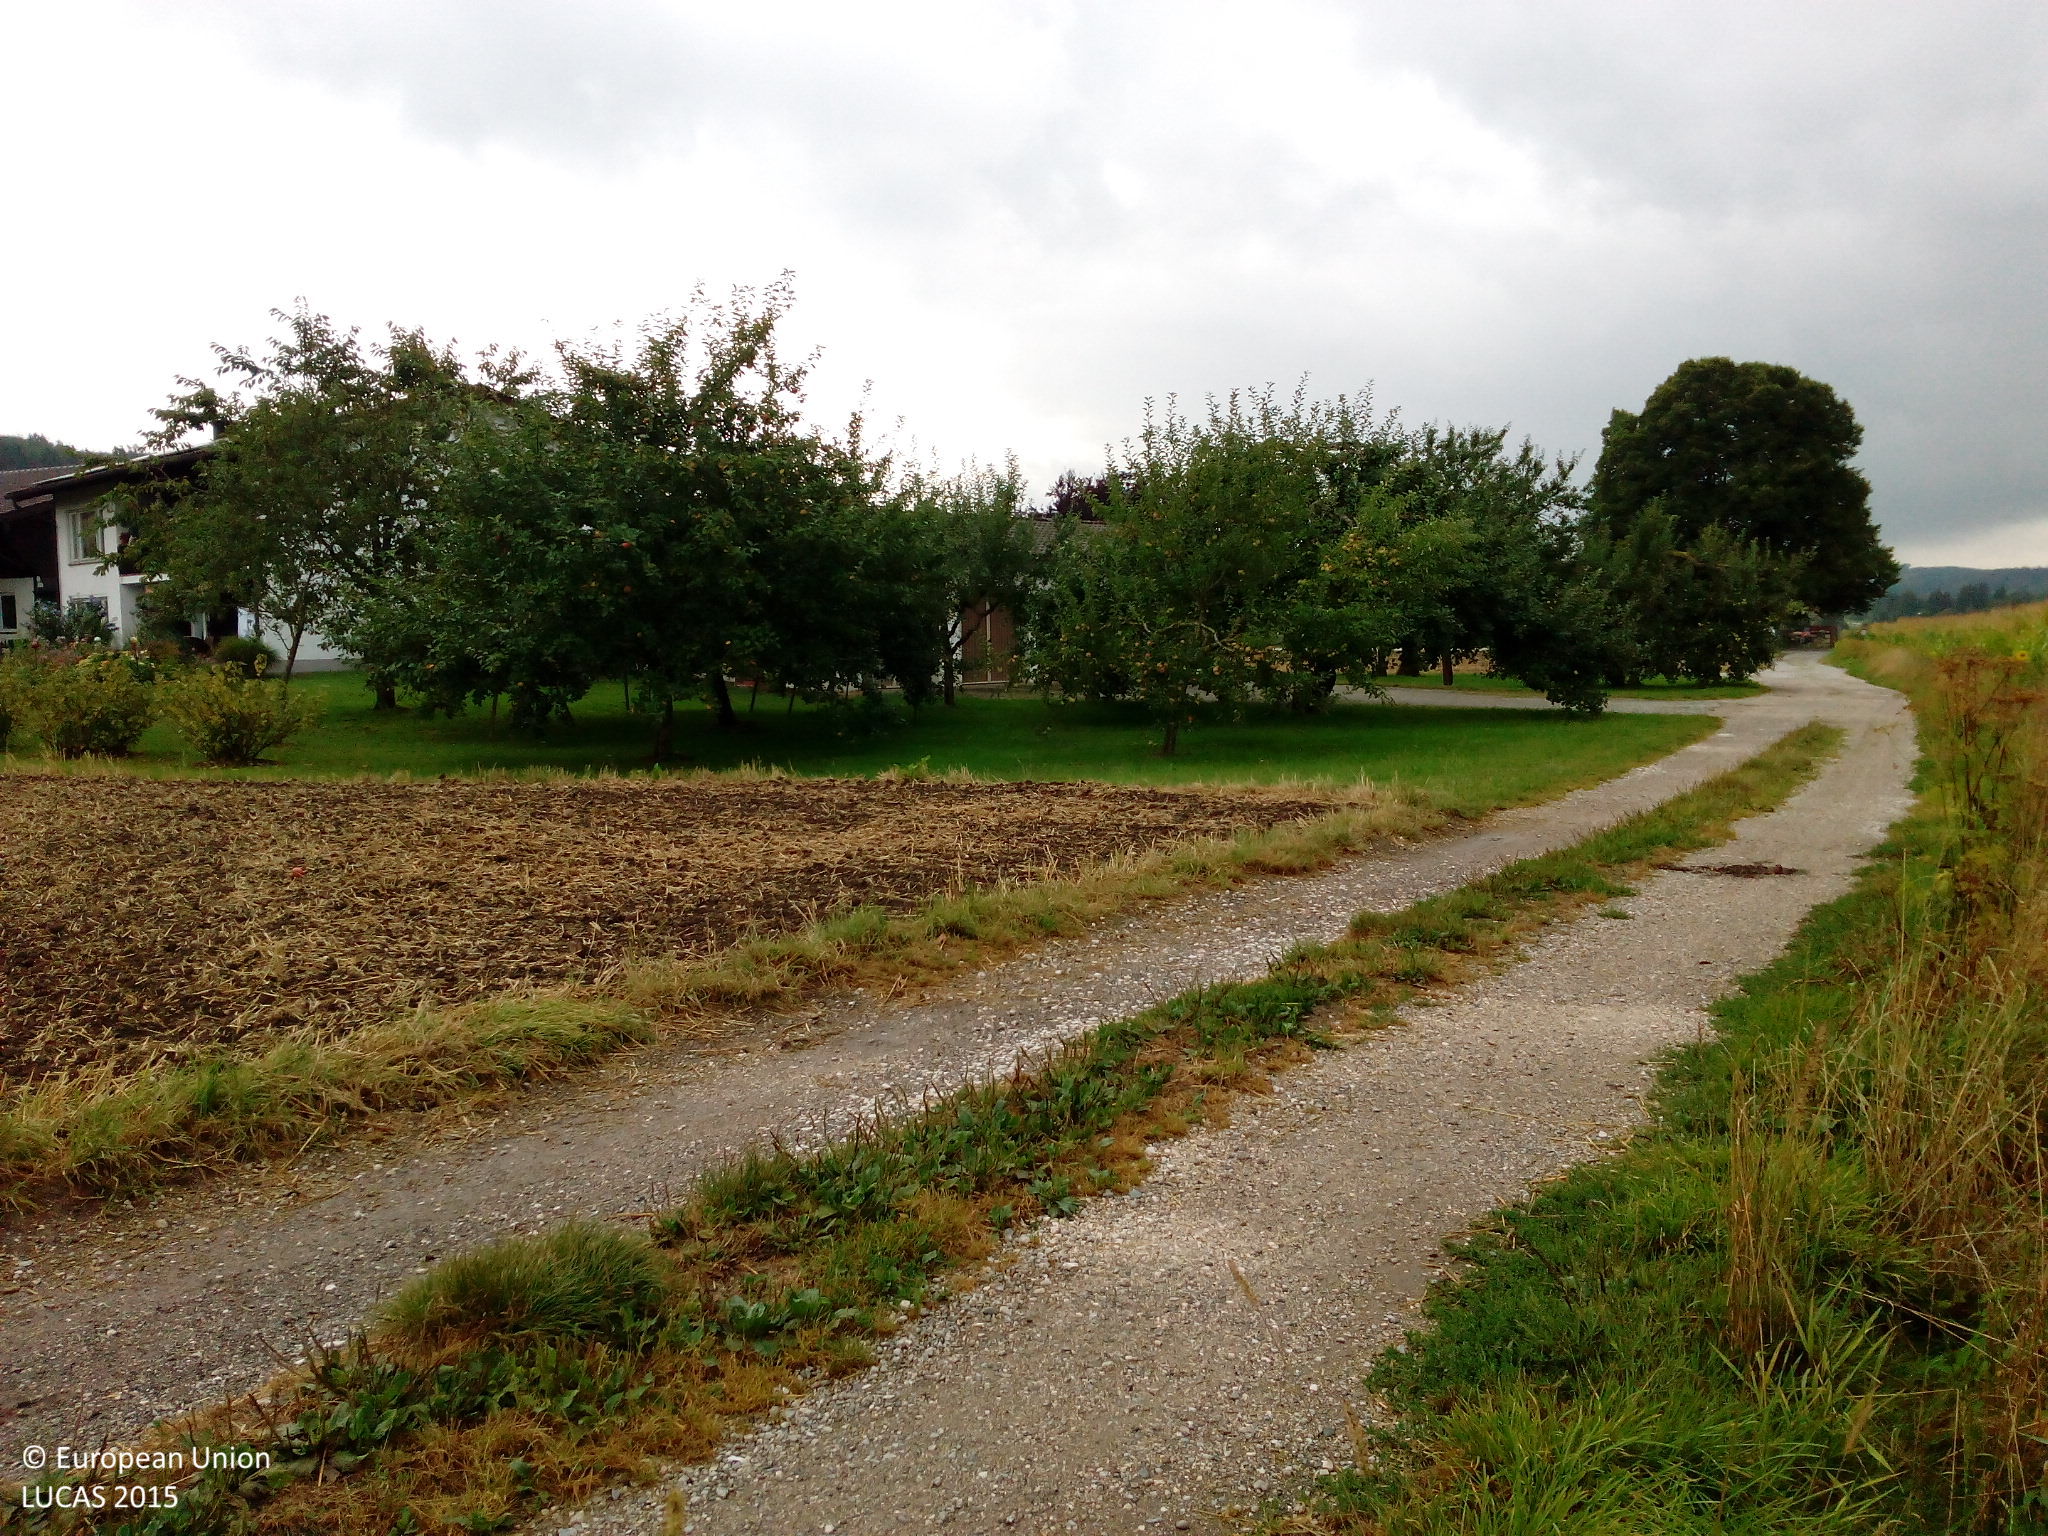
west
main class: Cropland
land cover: Maize
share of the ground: > 75 %
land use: Agriculture (excluding fallow land and kitchen gardens)
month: August
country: DE
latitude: 47.8454
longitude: 12.8182
